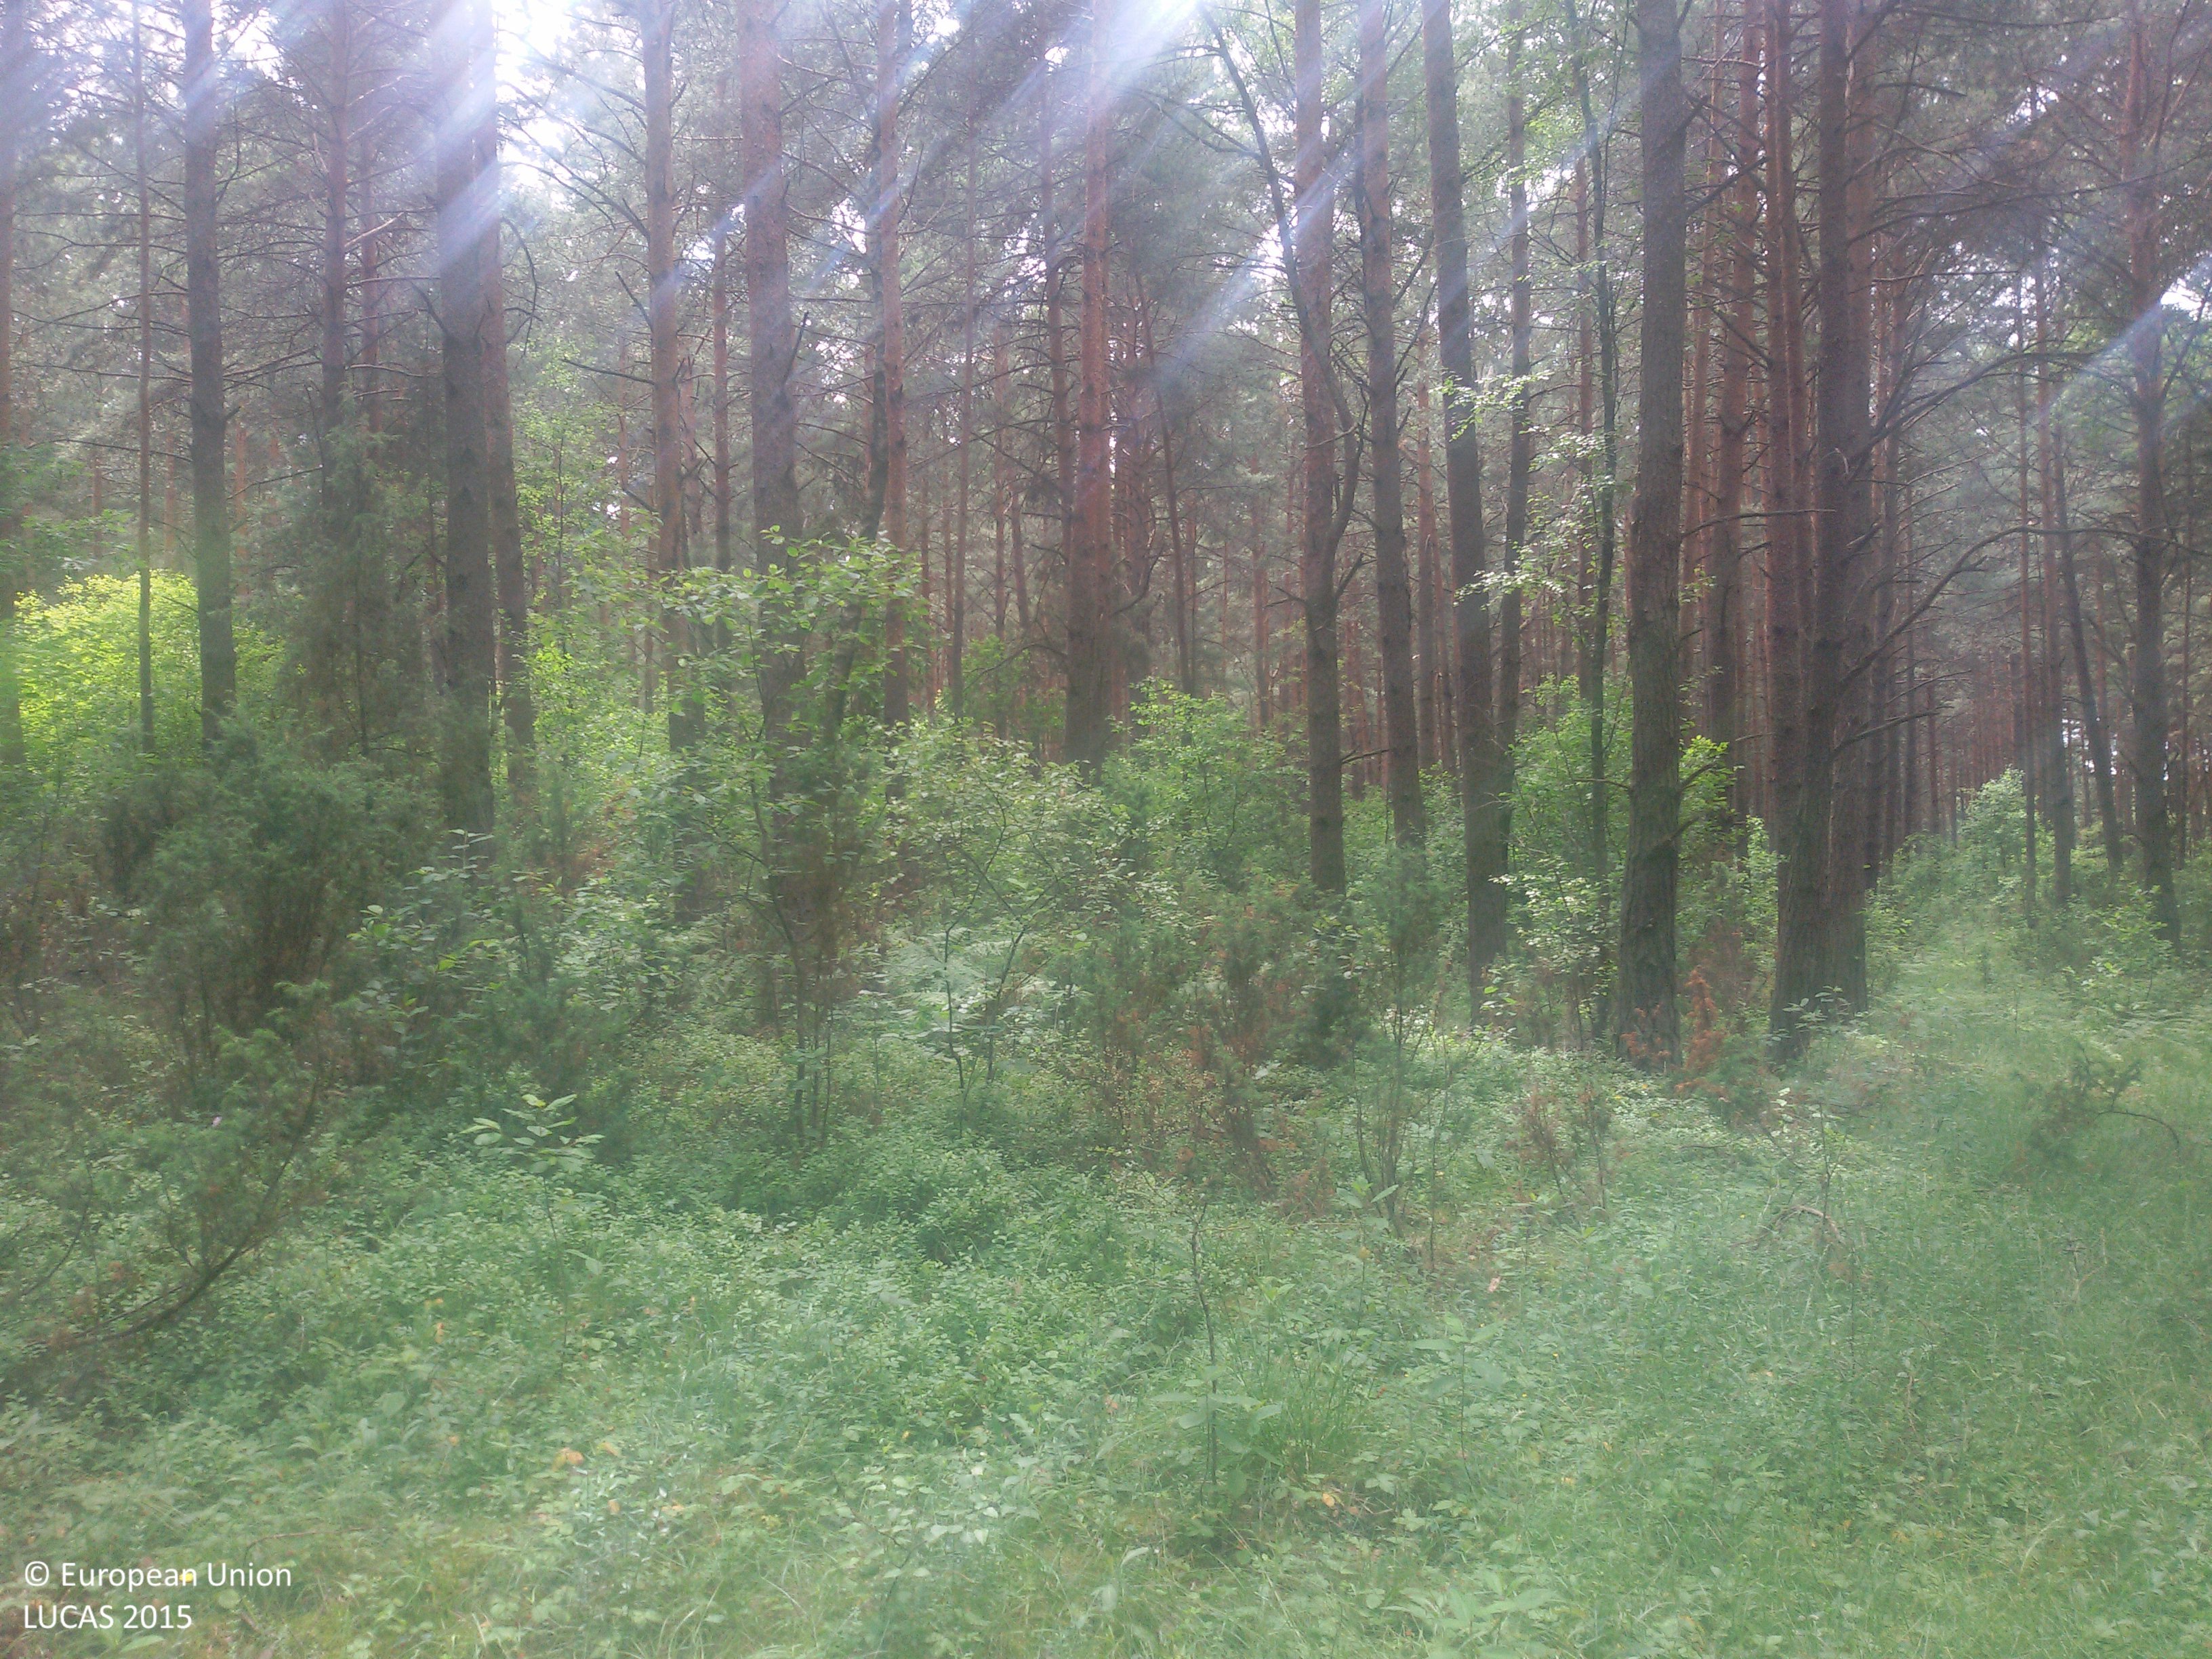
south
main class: Woodland
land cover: Pine dominated coniferous woodland
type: hemiboreal forest and nemoral coniferous forest and mixed broadleaved-coniferous forest
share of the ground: > 75 %
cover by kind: coniferous forest trees 70 %, broadleaved forest trees 15 %, herbaceous plants 15 %
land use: Forestry
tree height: > 5 m
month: June
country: PL
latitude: 51.2293
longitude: 20.9997
